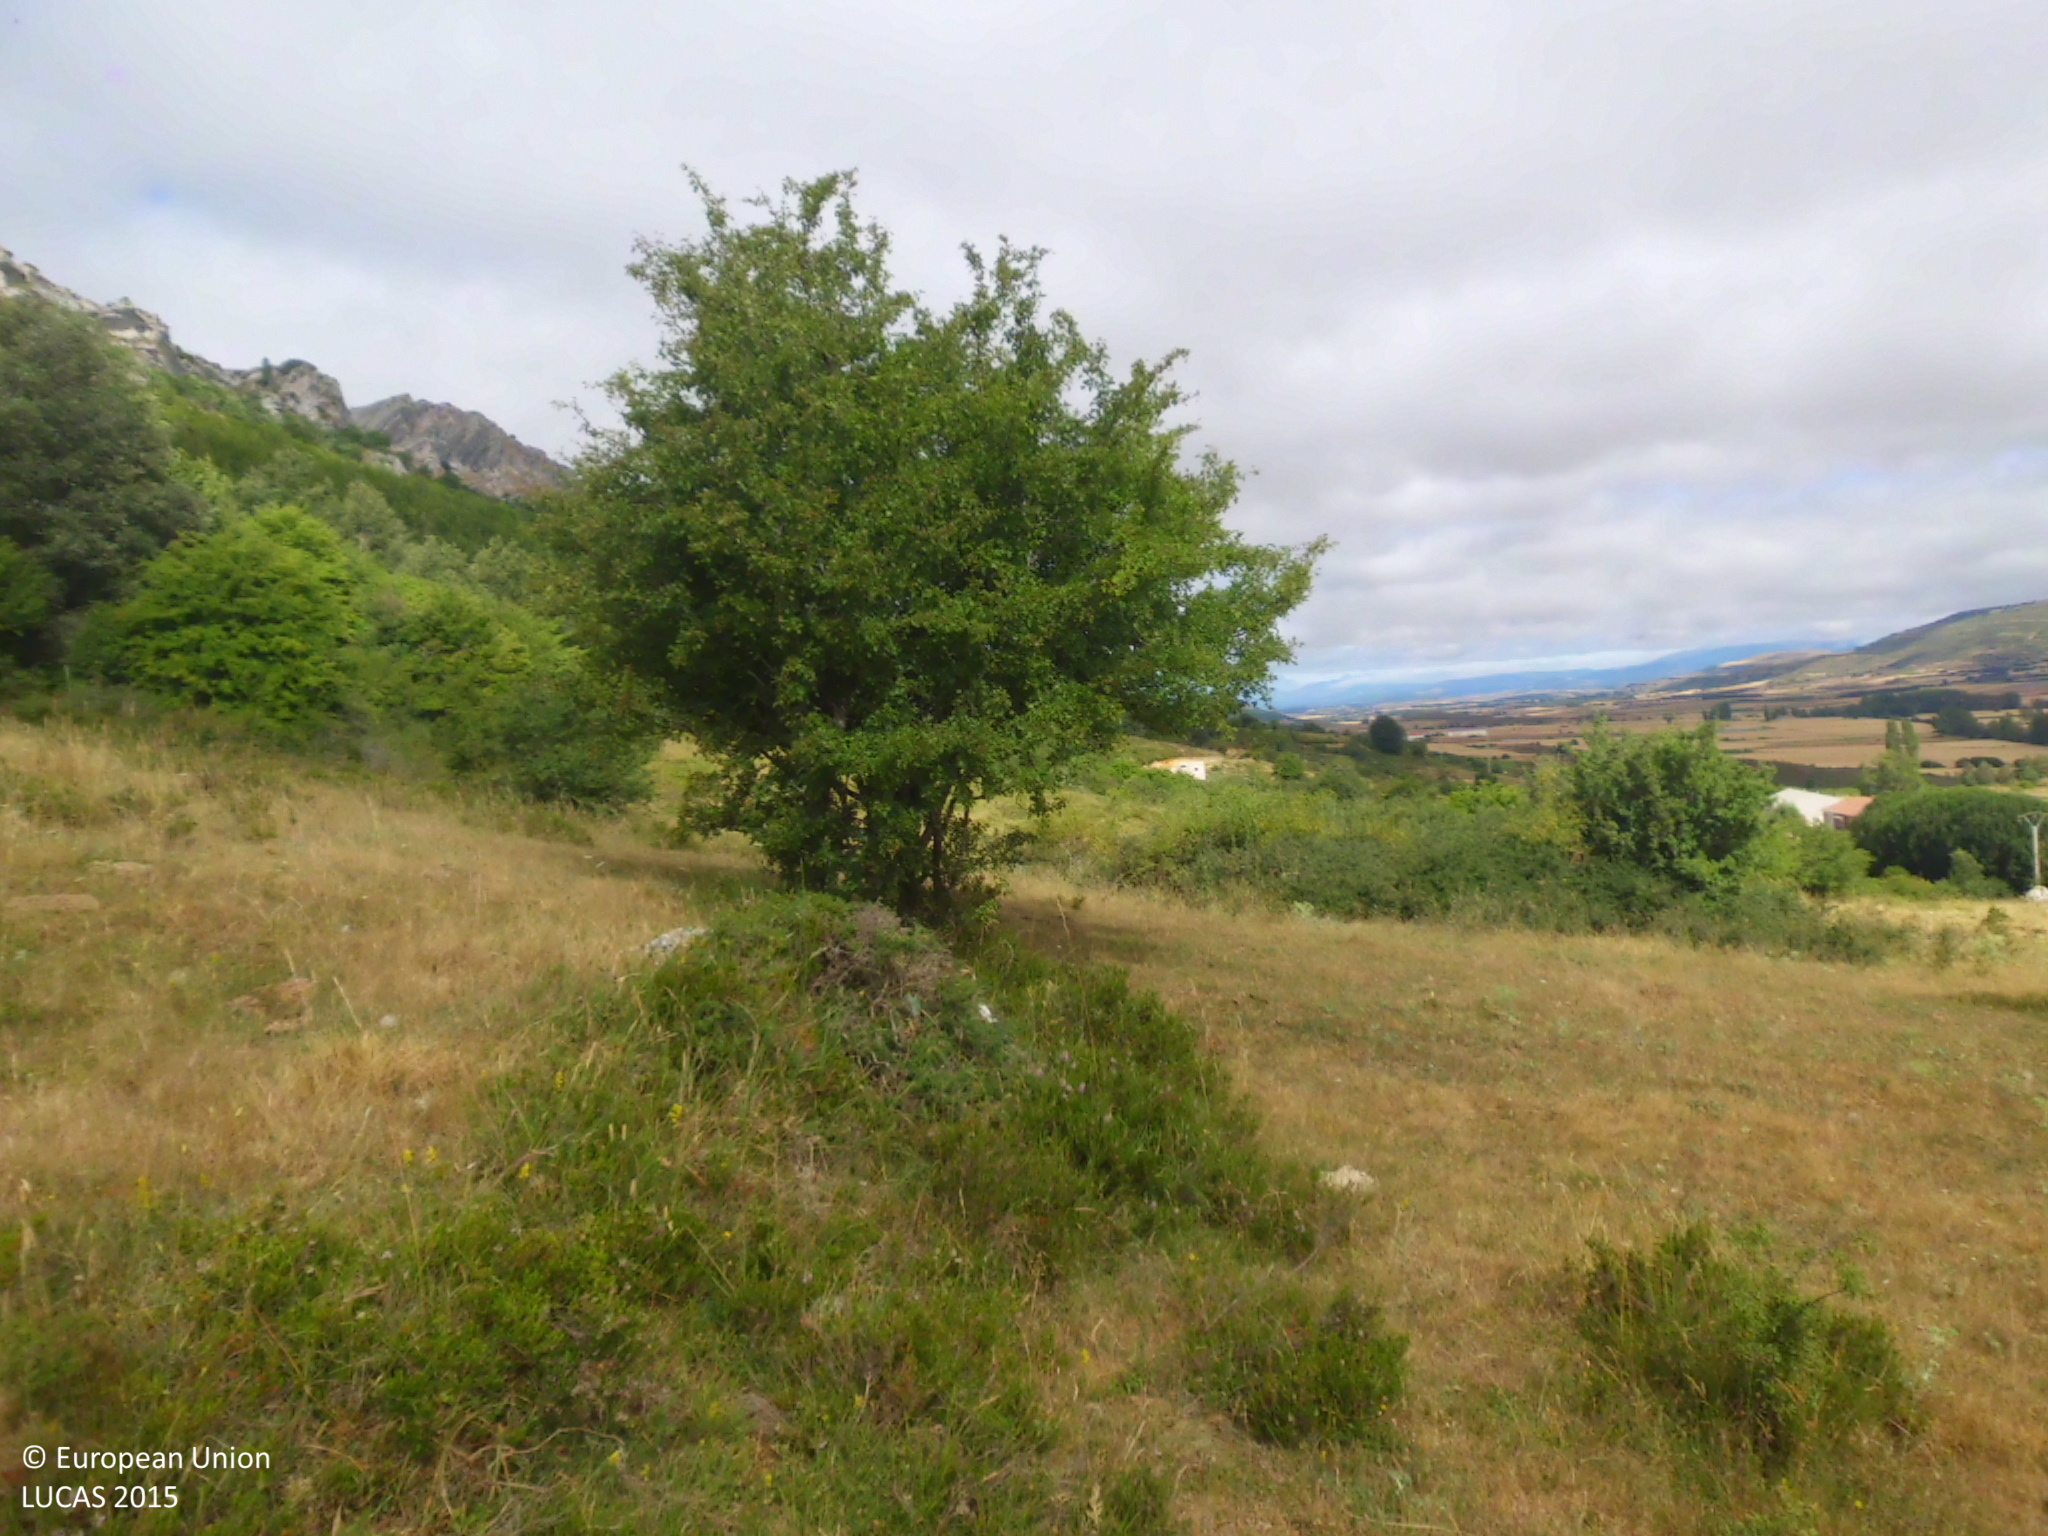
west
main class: Shrubland
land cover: Shrubland without tree cover
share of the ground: 25 - 50 %
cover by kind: herbaceous plants 55 %, shrubs 35 %, consolidated bare surface 10 %
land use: Agriculture (excluding fallow land and kitchen gardens)
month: July
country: ES
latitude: 42.7055
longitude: -4.0985
